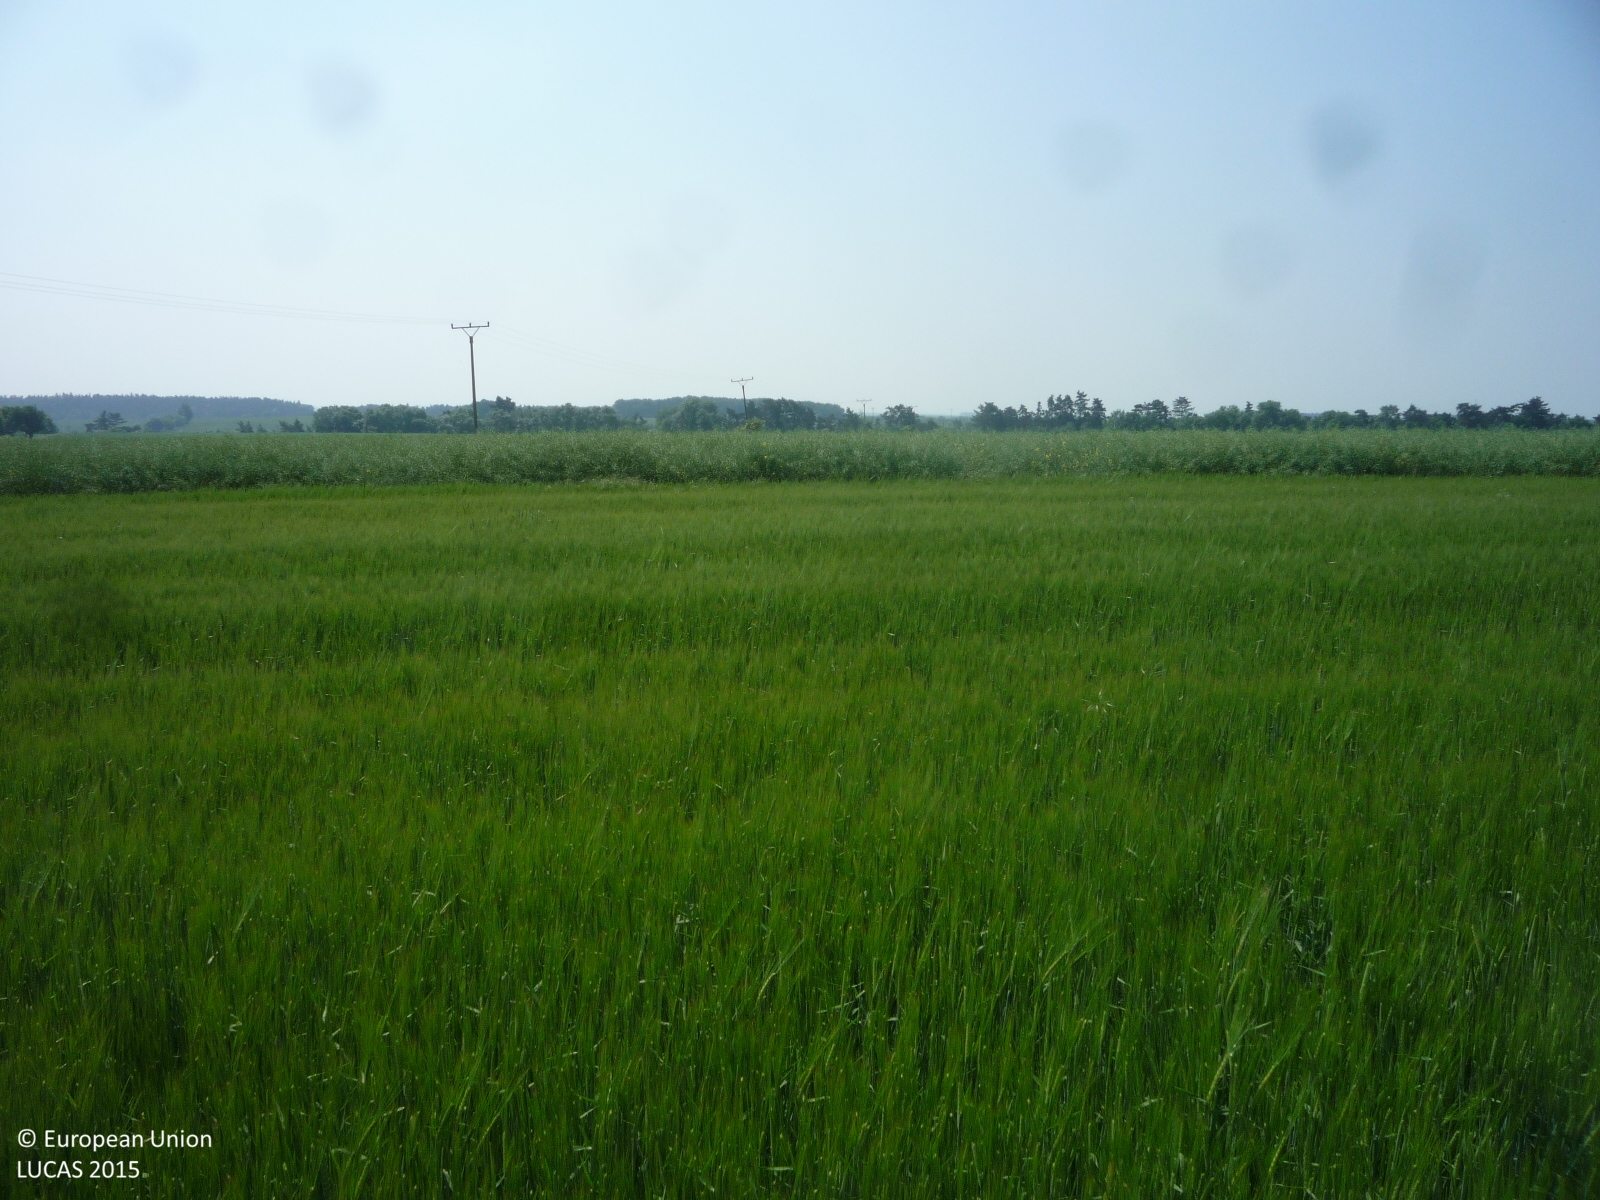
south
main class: Cropland
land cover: Barley
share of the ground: > 75 %
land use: Agriculture (excluding fallow land and kitchen gardens)
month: June
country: CZ
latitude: 50.3280
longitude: 14.0607
